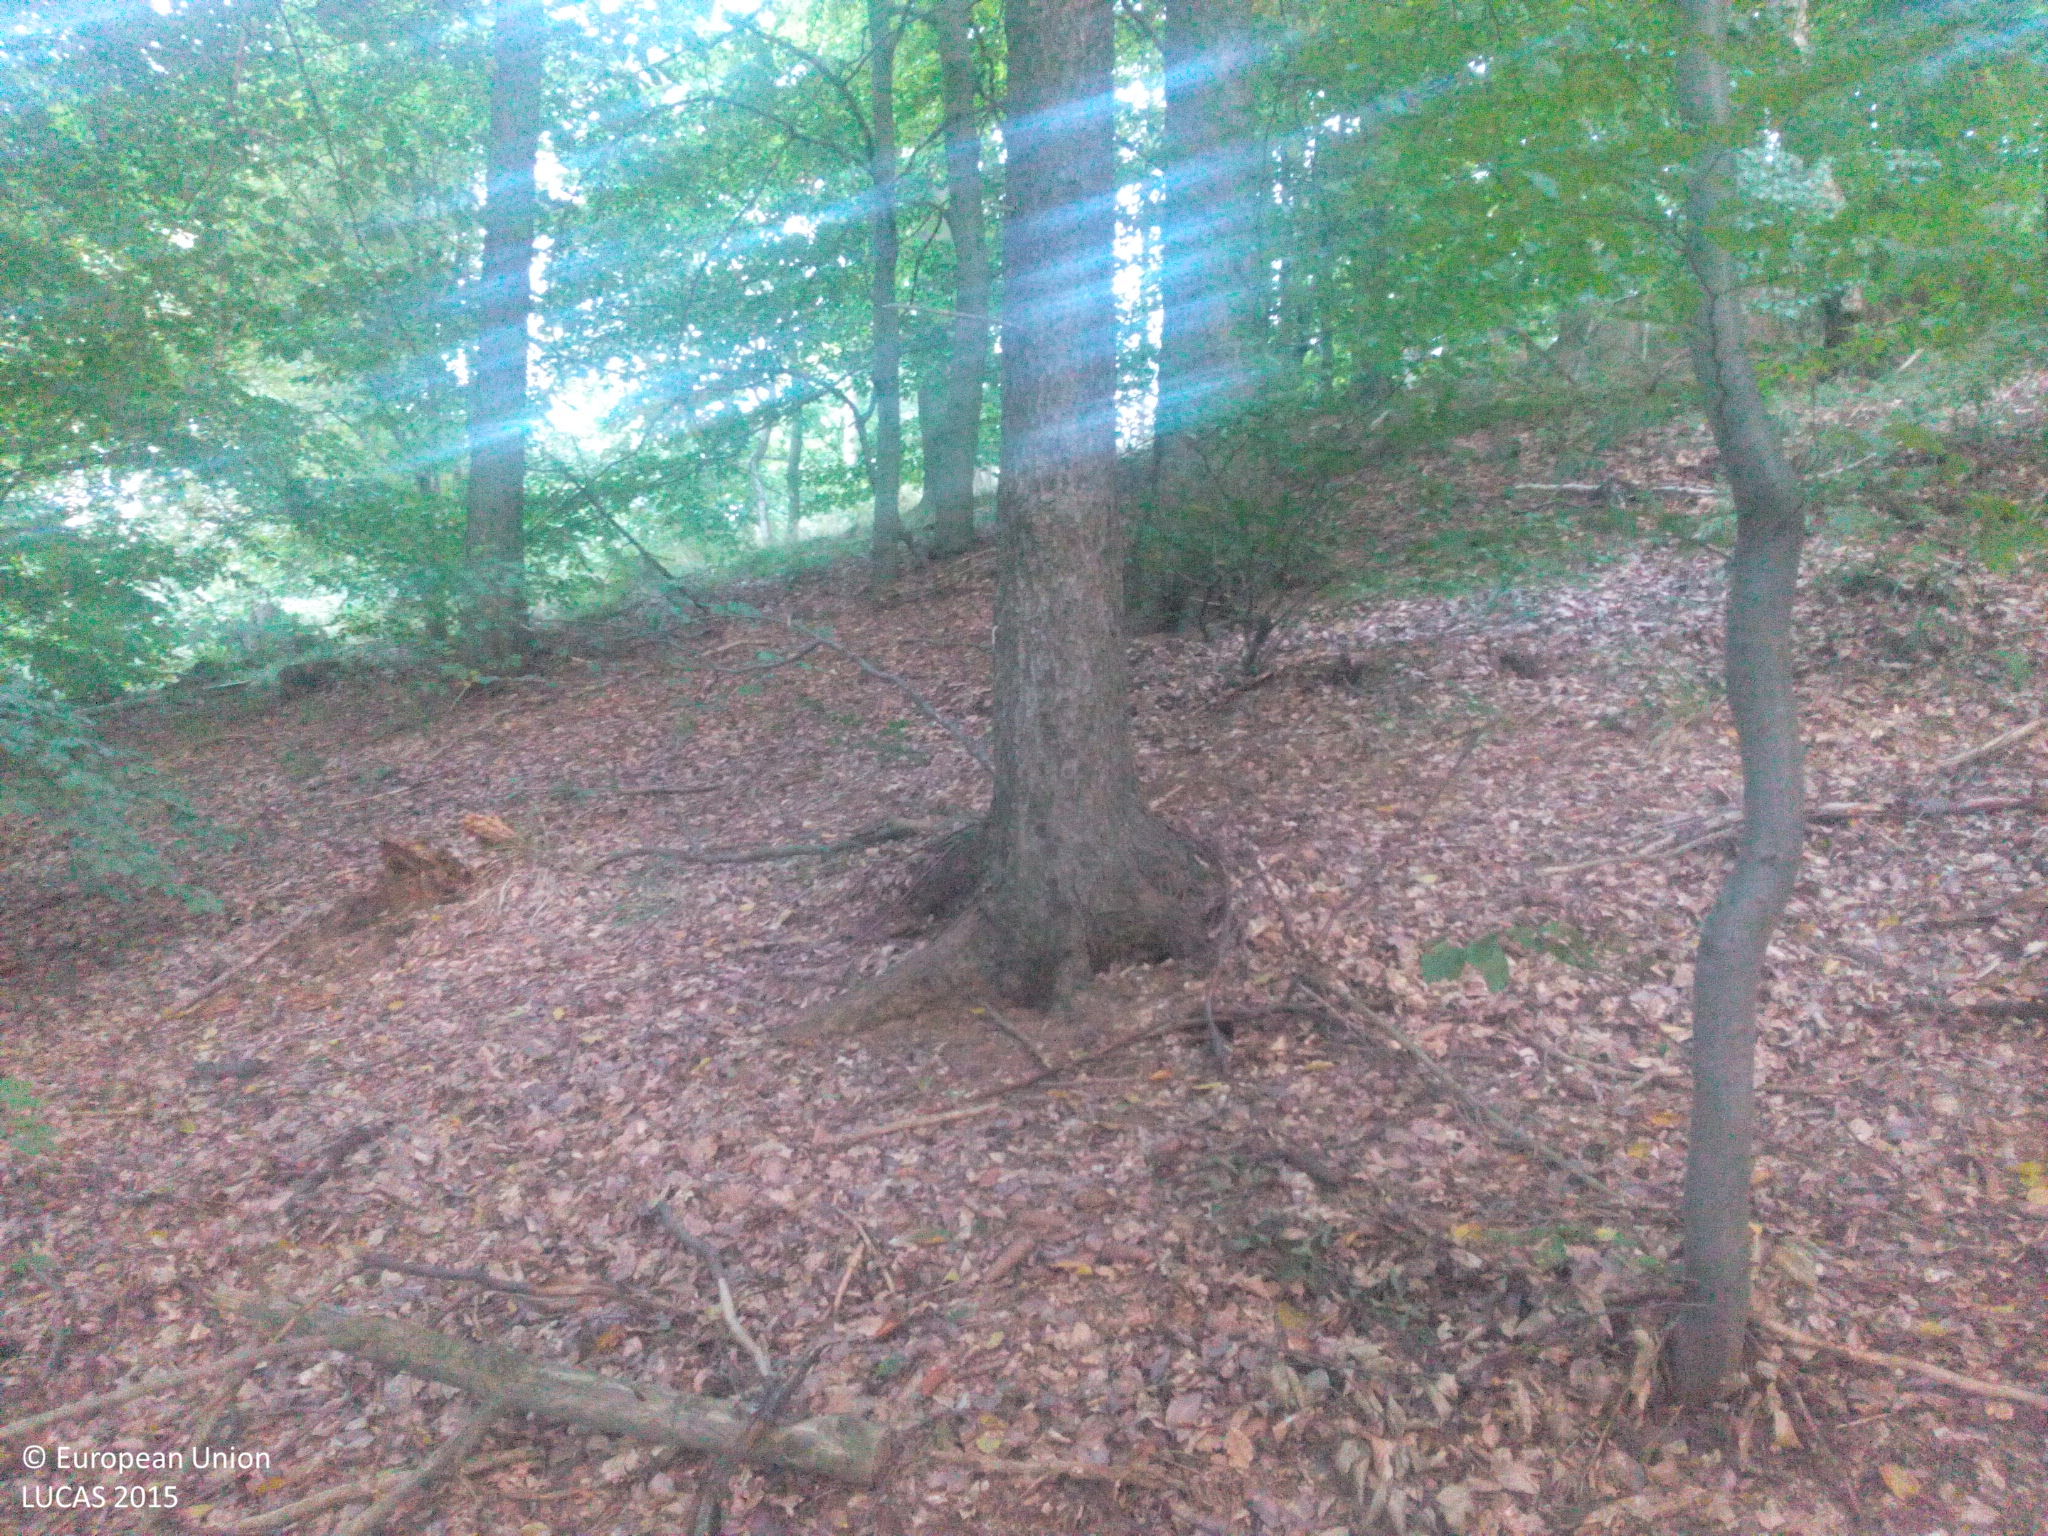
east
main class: Woodland
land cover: Spruce dominated mixed woodland
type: hemiboreal forest and nemoral coniferous forest and mixed broadleaved-coniferous forest
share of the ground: > 75 %
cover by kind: coniferous forest trees 50 %, broadleaved forest trees 50 %
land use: Forestry
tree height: > 5 m
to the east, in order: Spruce dominated mixed woodland; Tracks; Broadleaved woodland; Tracks; Broadleaved woodland
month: September
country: DE
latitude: 51.4198
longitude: 11.0782
